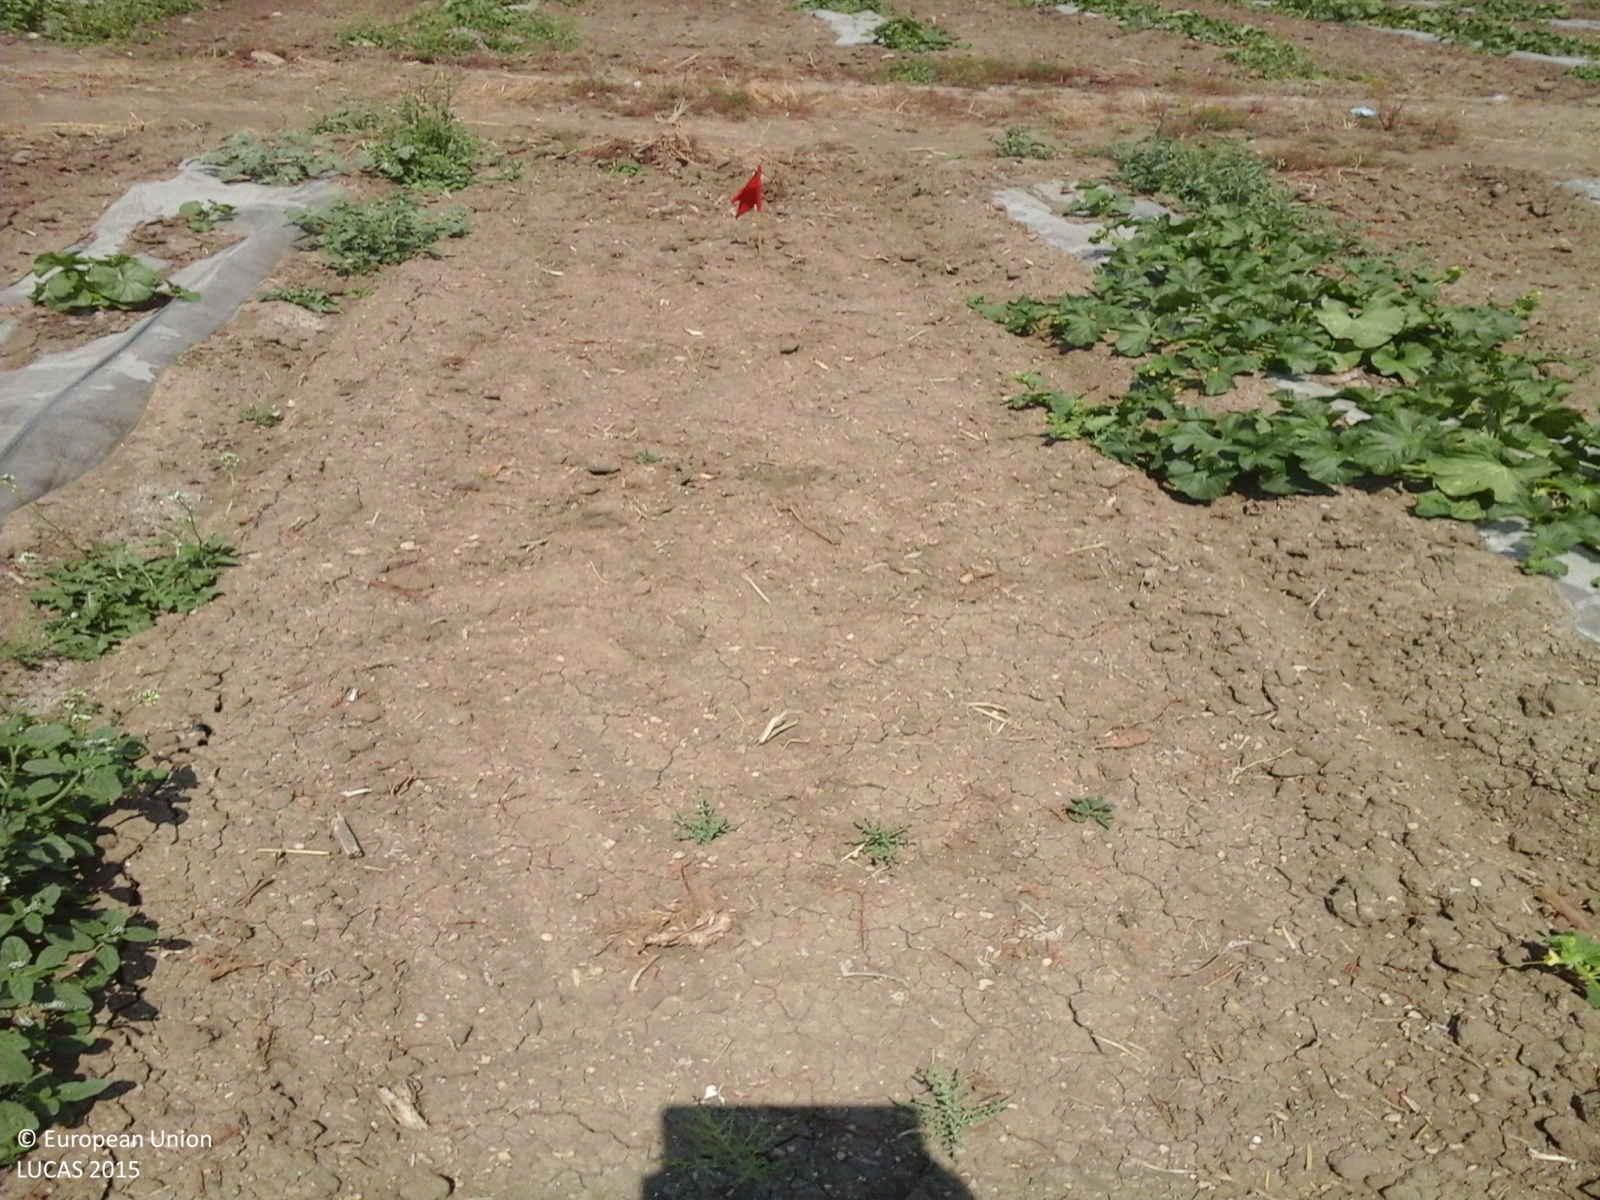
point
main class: Cropland
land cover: Other fresh vegetables
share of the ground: > 75 %
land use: Agriculture (excluding fallow land and kitchen gardens)
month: July
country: IT
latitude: 37.1904
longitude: 14.4156
